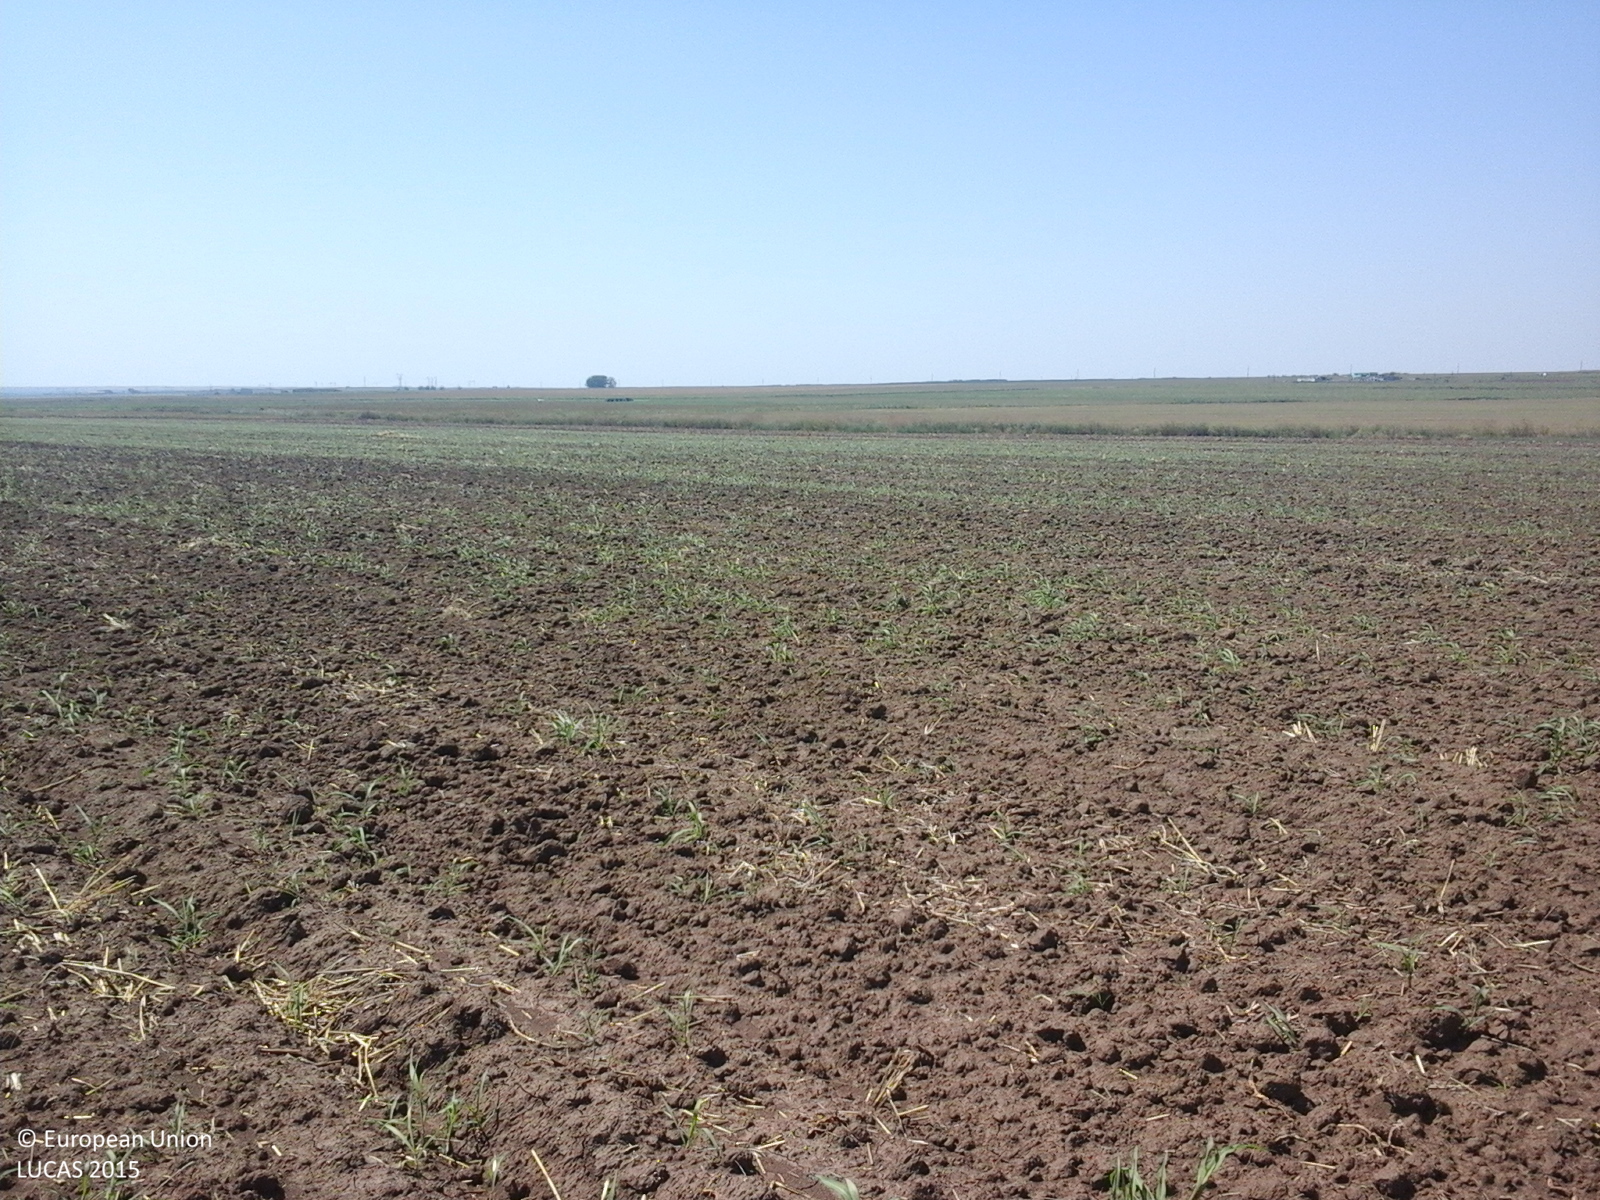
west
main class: Cropland
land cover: Common wheat
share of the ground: < 10 %
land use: Agriculture (excluding fallow land and kitchen gardens)
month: August
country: RO
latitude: 44.2364
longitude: 28.5138
